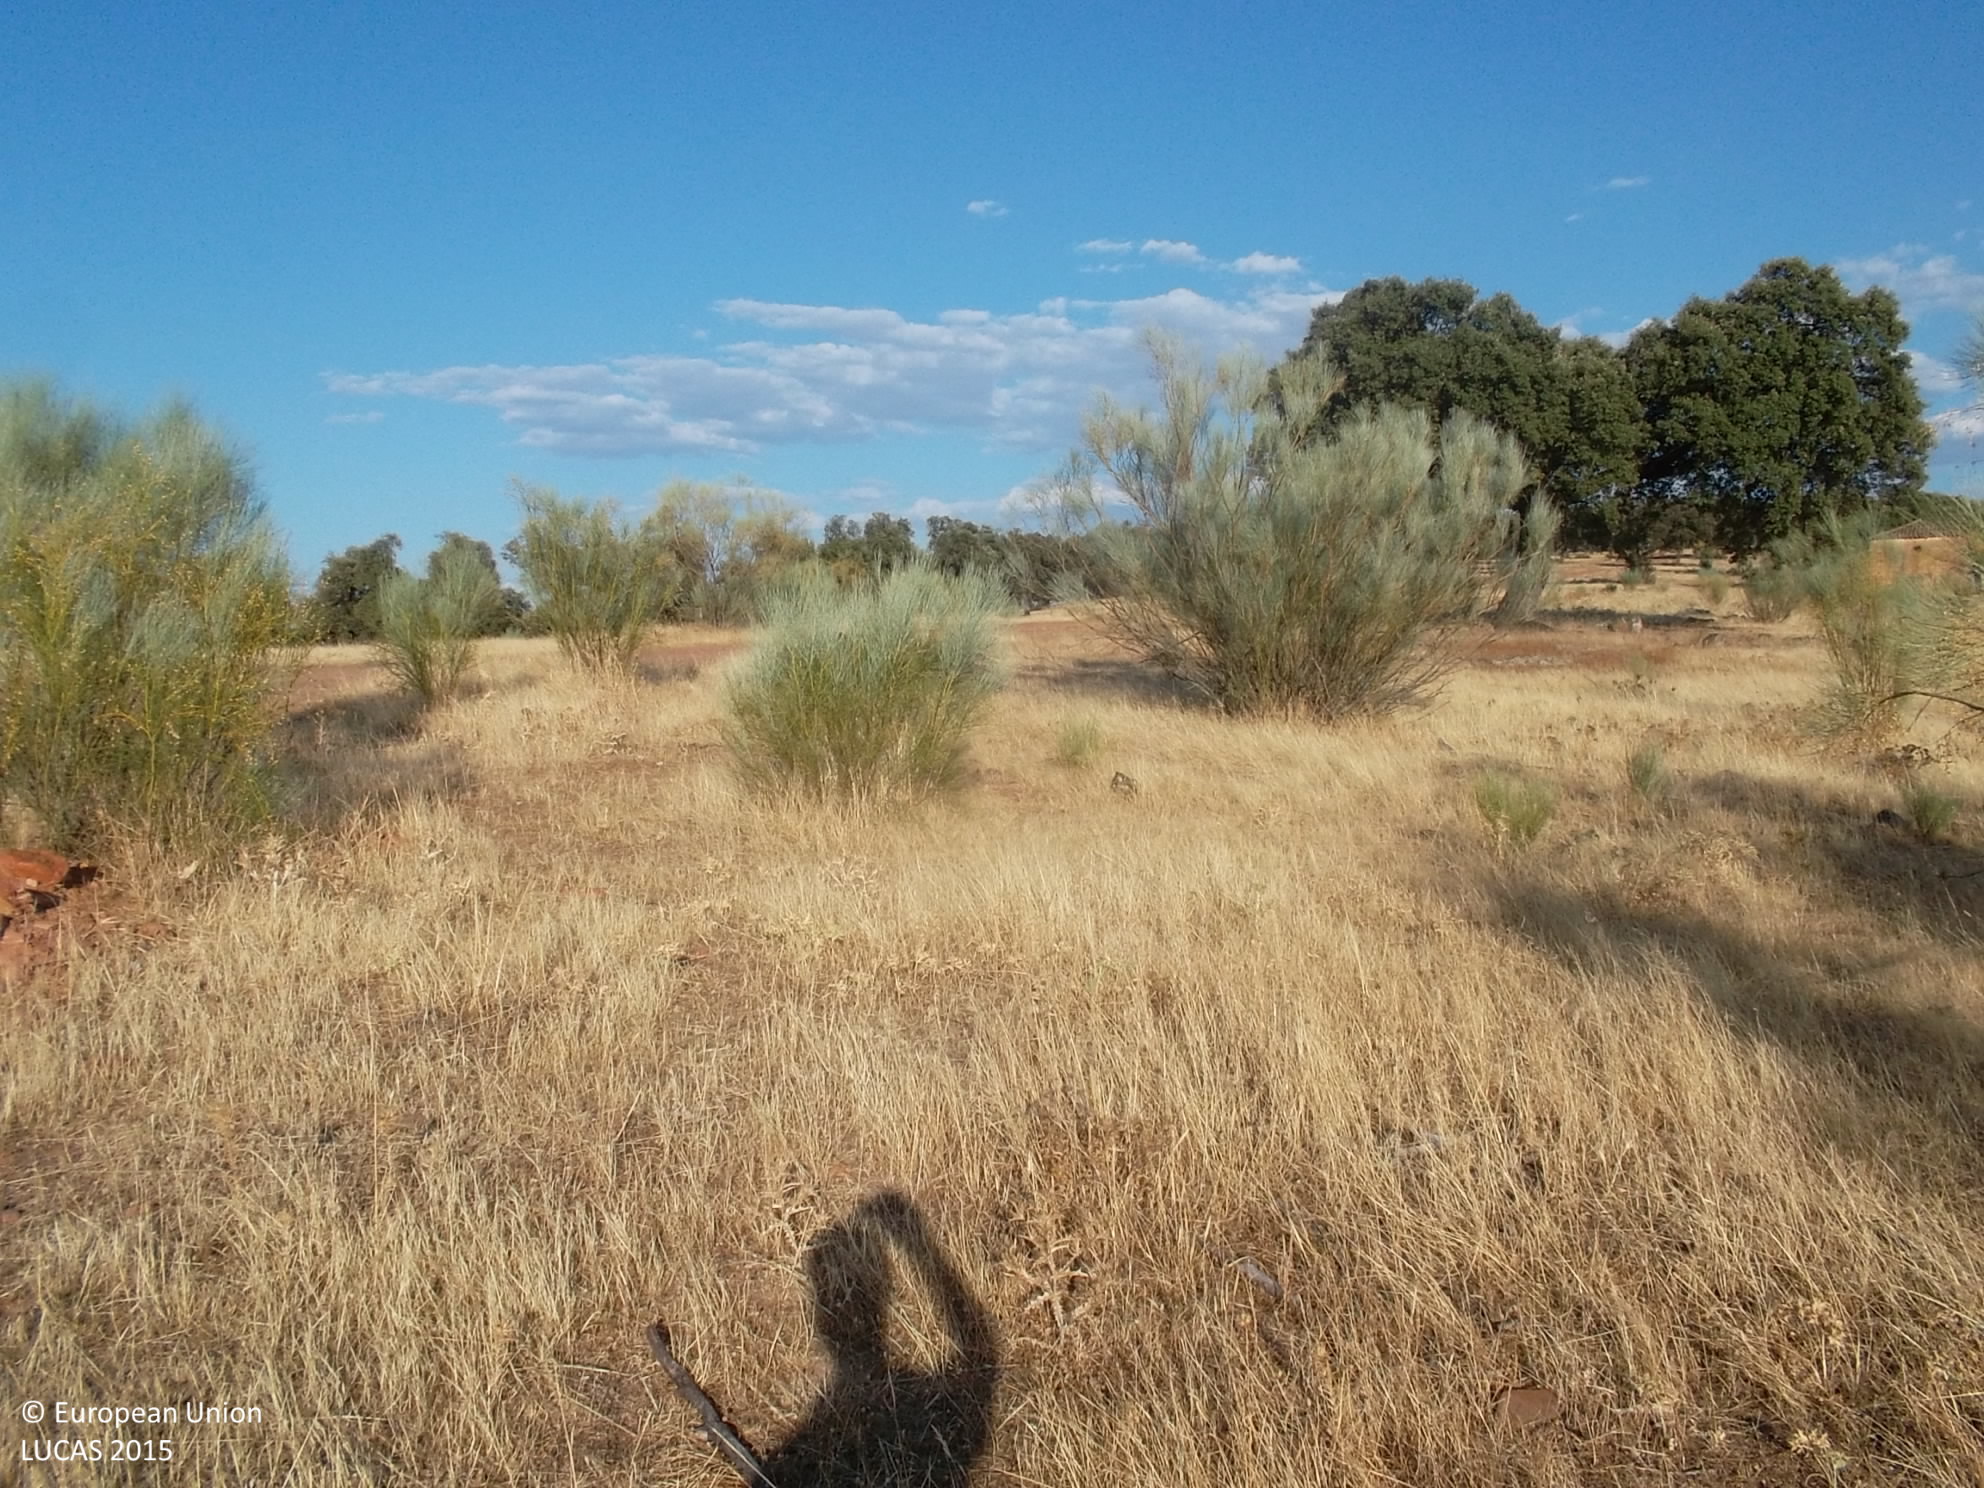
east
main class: Grassland
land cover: Grassland with sparse tree/shrub cover
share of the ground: > 75 %
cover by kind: herbaceous plants 90 %, broadleaved forest trees 5 %, shrubs 5 %
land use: Agriculture (excluding fallow land and kitchen gardens)
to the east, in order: Grassland with sparse tree/shrub cover; Tracks; Grassland with sparse tree/shrub cover; Broadleaved woodland; Tracks; Broadleaved woodland
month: July
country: ES
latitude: 38.5338
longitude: -5.8150
